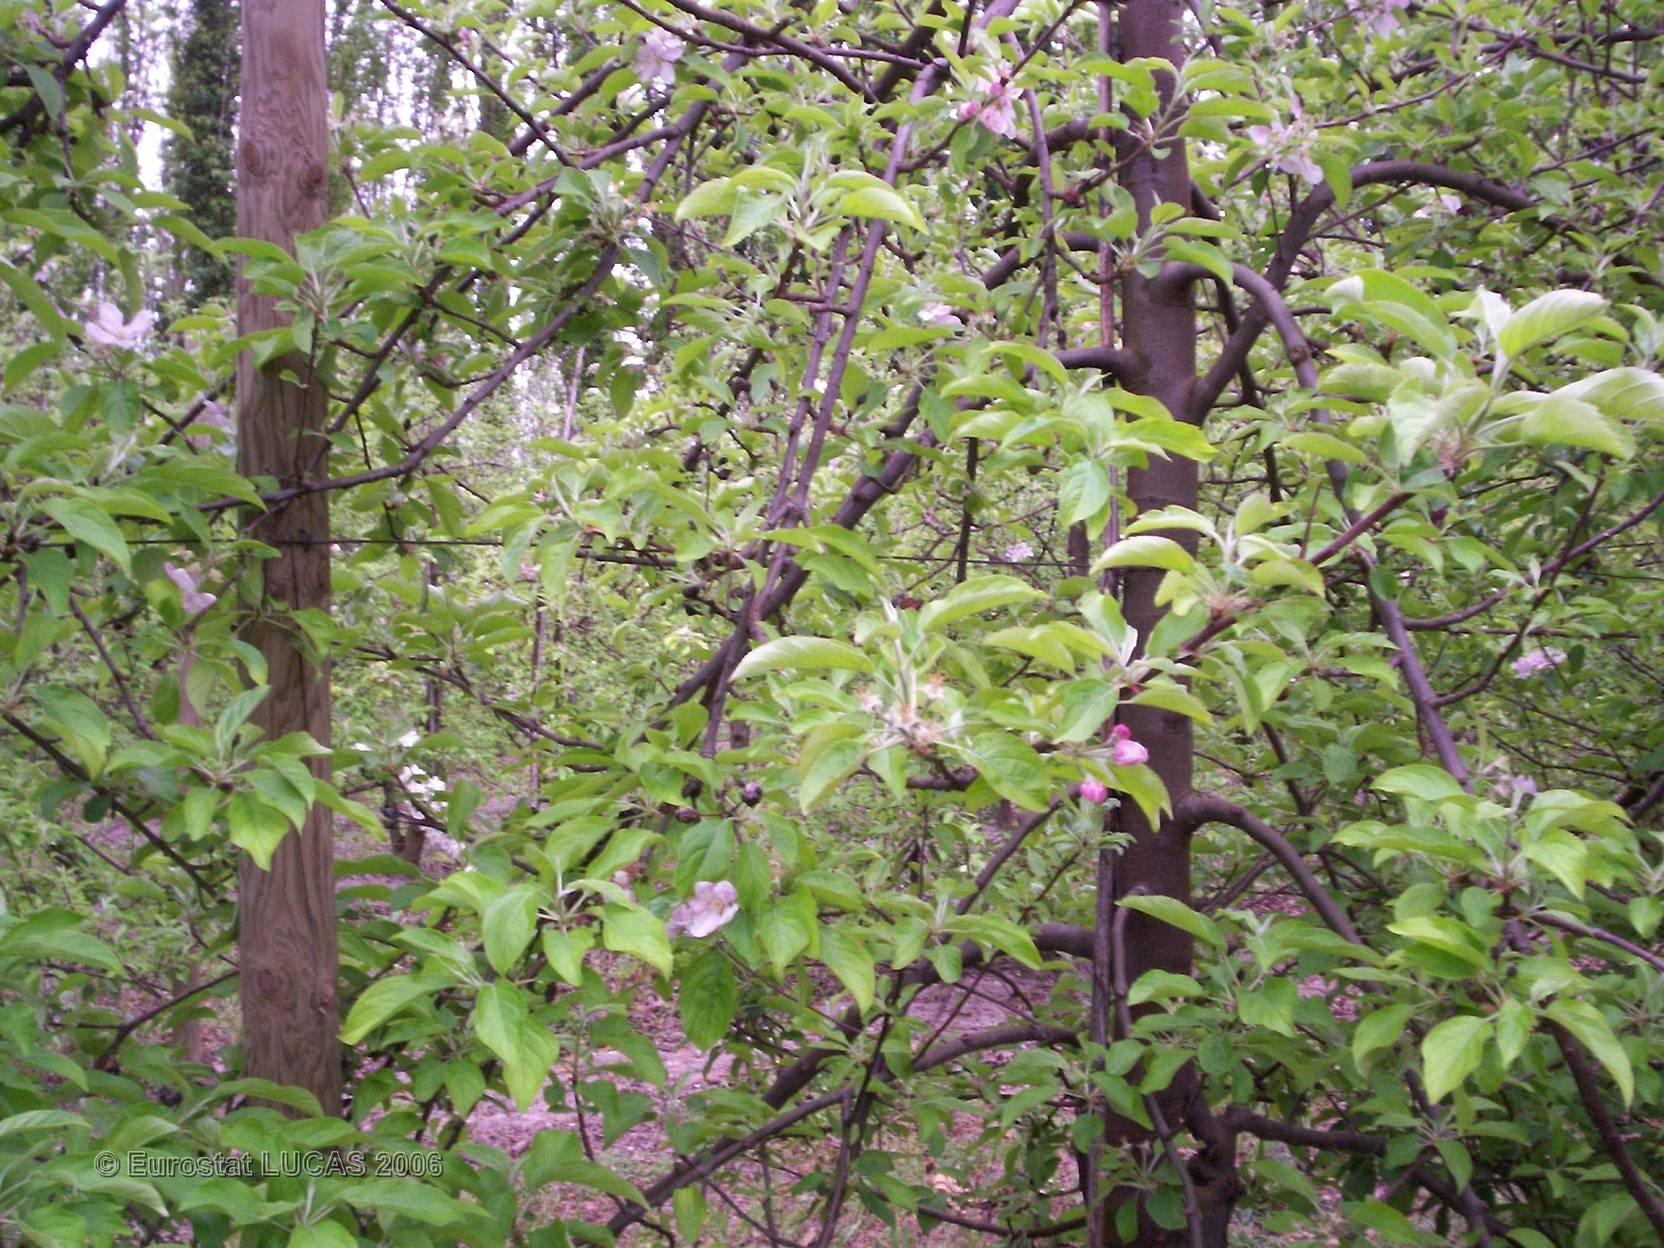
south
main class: Cropland
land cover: Apple fruit
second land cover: Grassland with sparse tree/shrub cover
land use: Agriculture (excluding fallow land and kitchen gardens)
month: April
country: FR
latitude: 43.8287
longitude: 4.9230
